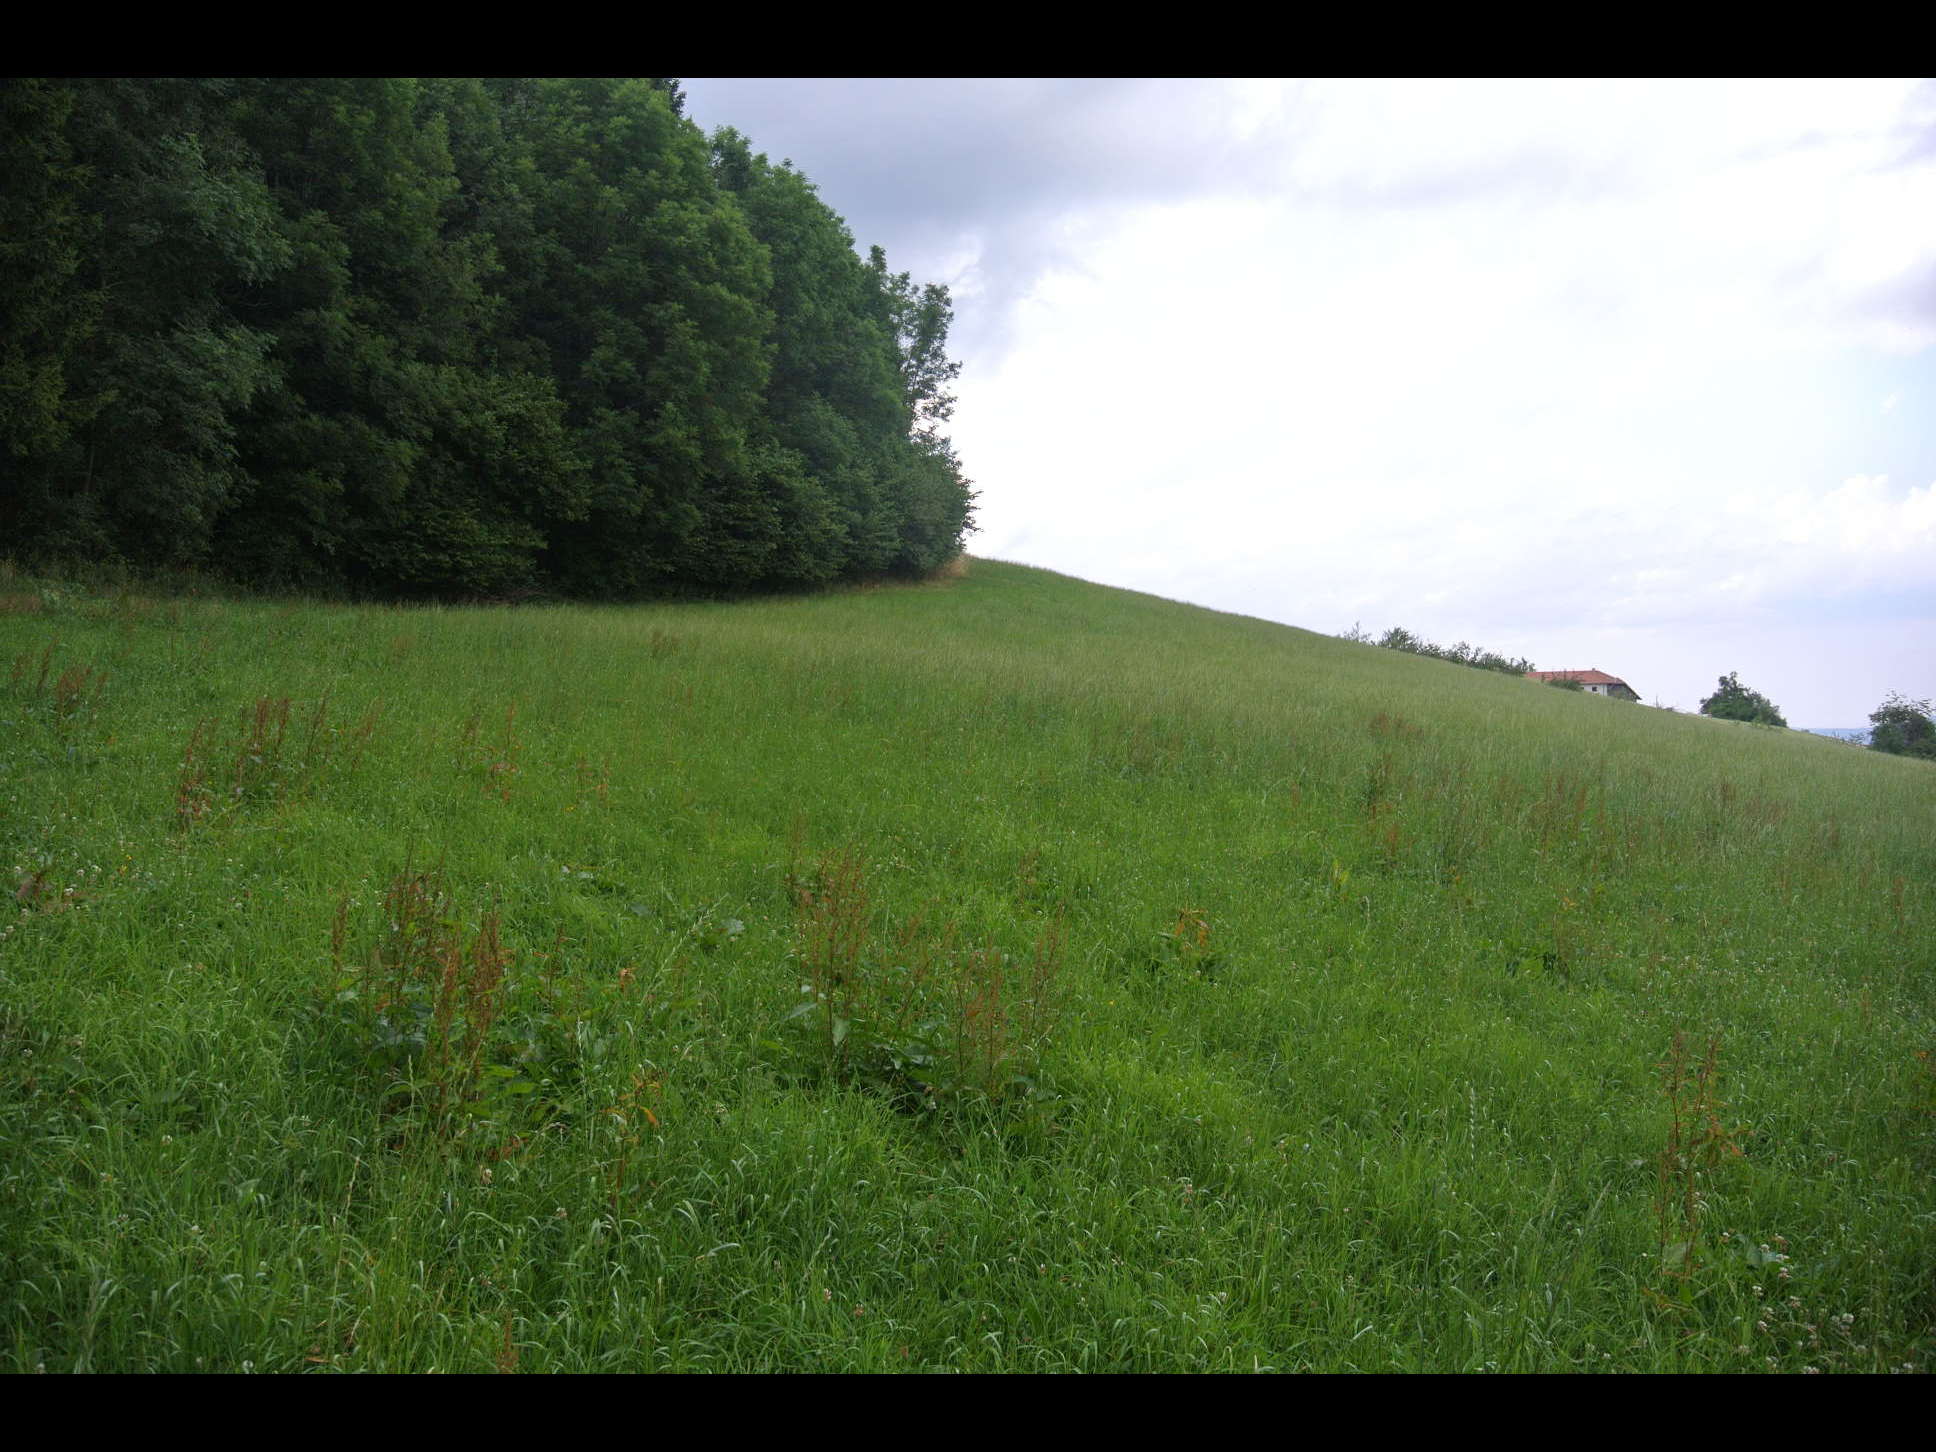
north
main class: Grassland
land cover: Grassland without tree/shrub cover
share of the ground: > 75 %
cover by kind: herbaceous plants 100 %
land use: Agriculture (excluding fallow land and kitchen gardens)
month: July
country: AT
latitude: 47.5163
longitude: 16.0445
